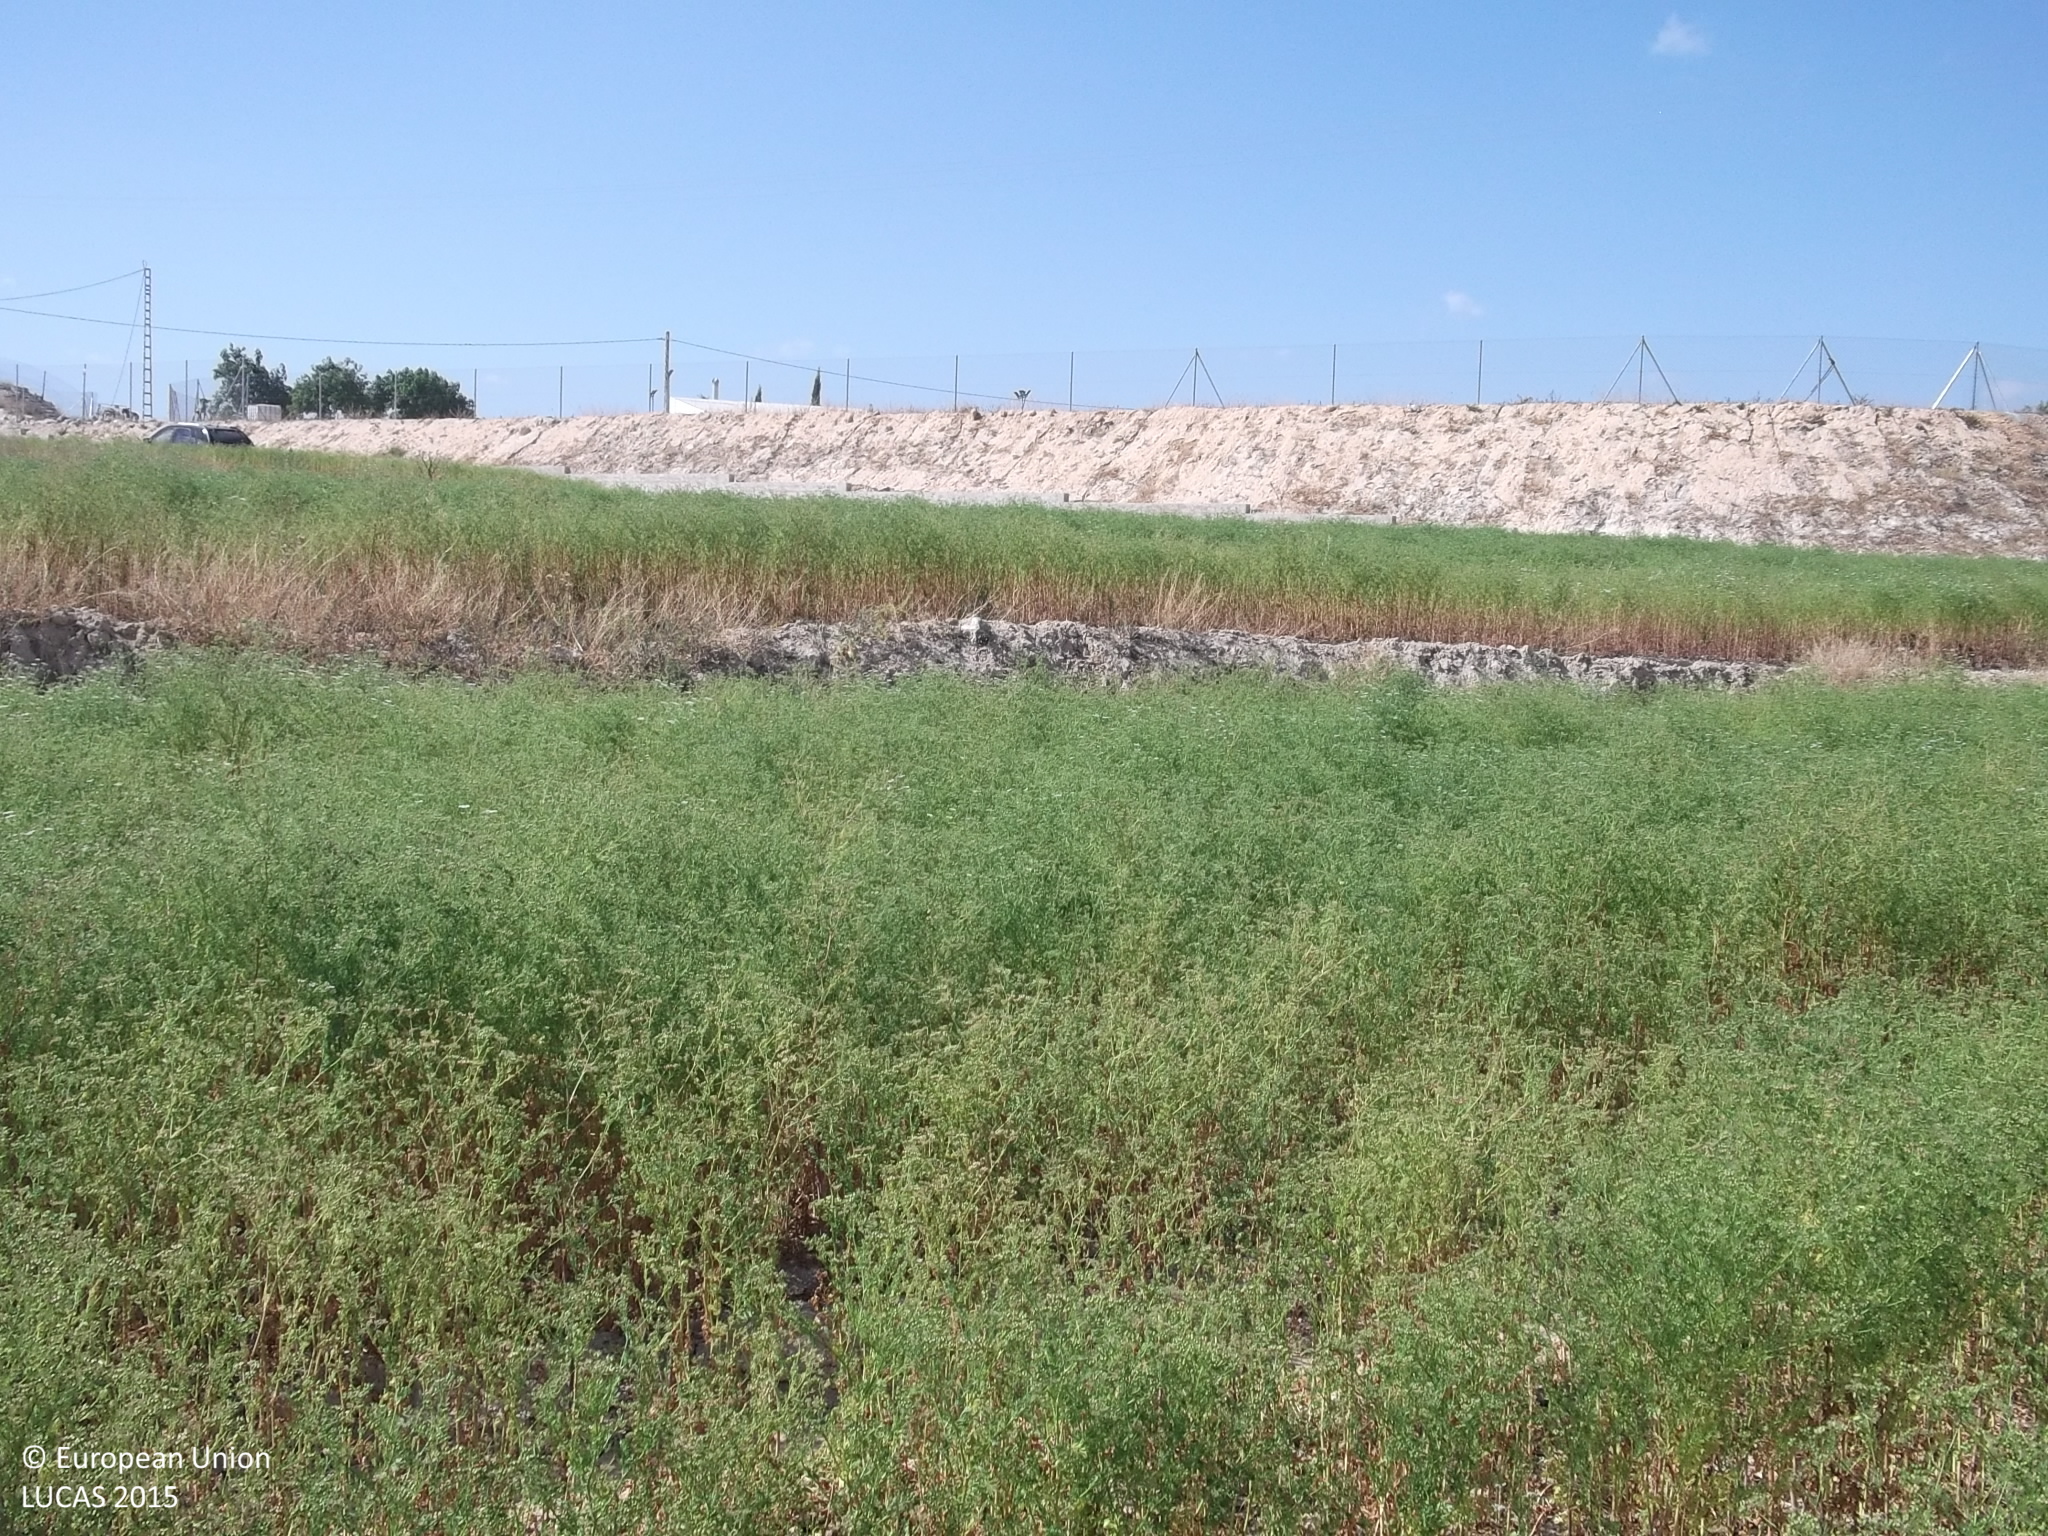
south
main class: Cropland
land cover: Other non-permanent industrial crops
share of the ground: > 75 %
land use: Agriculture (excluding fallow land and kitchen gardens)
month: May
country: ES
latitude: 38.0577
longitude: -0.8447
